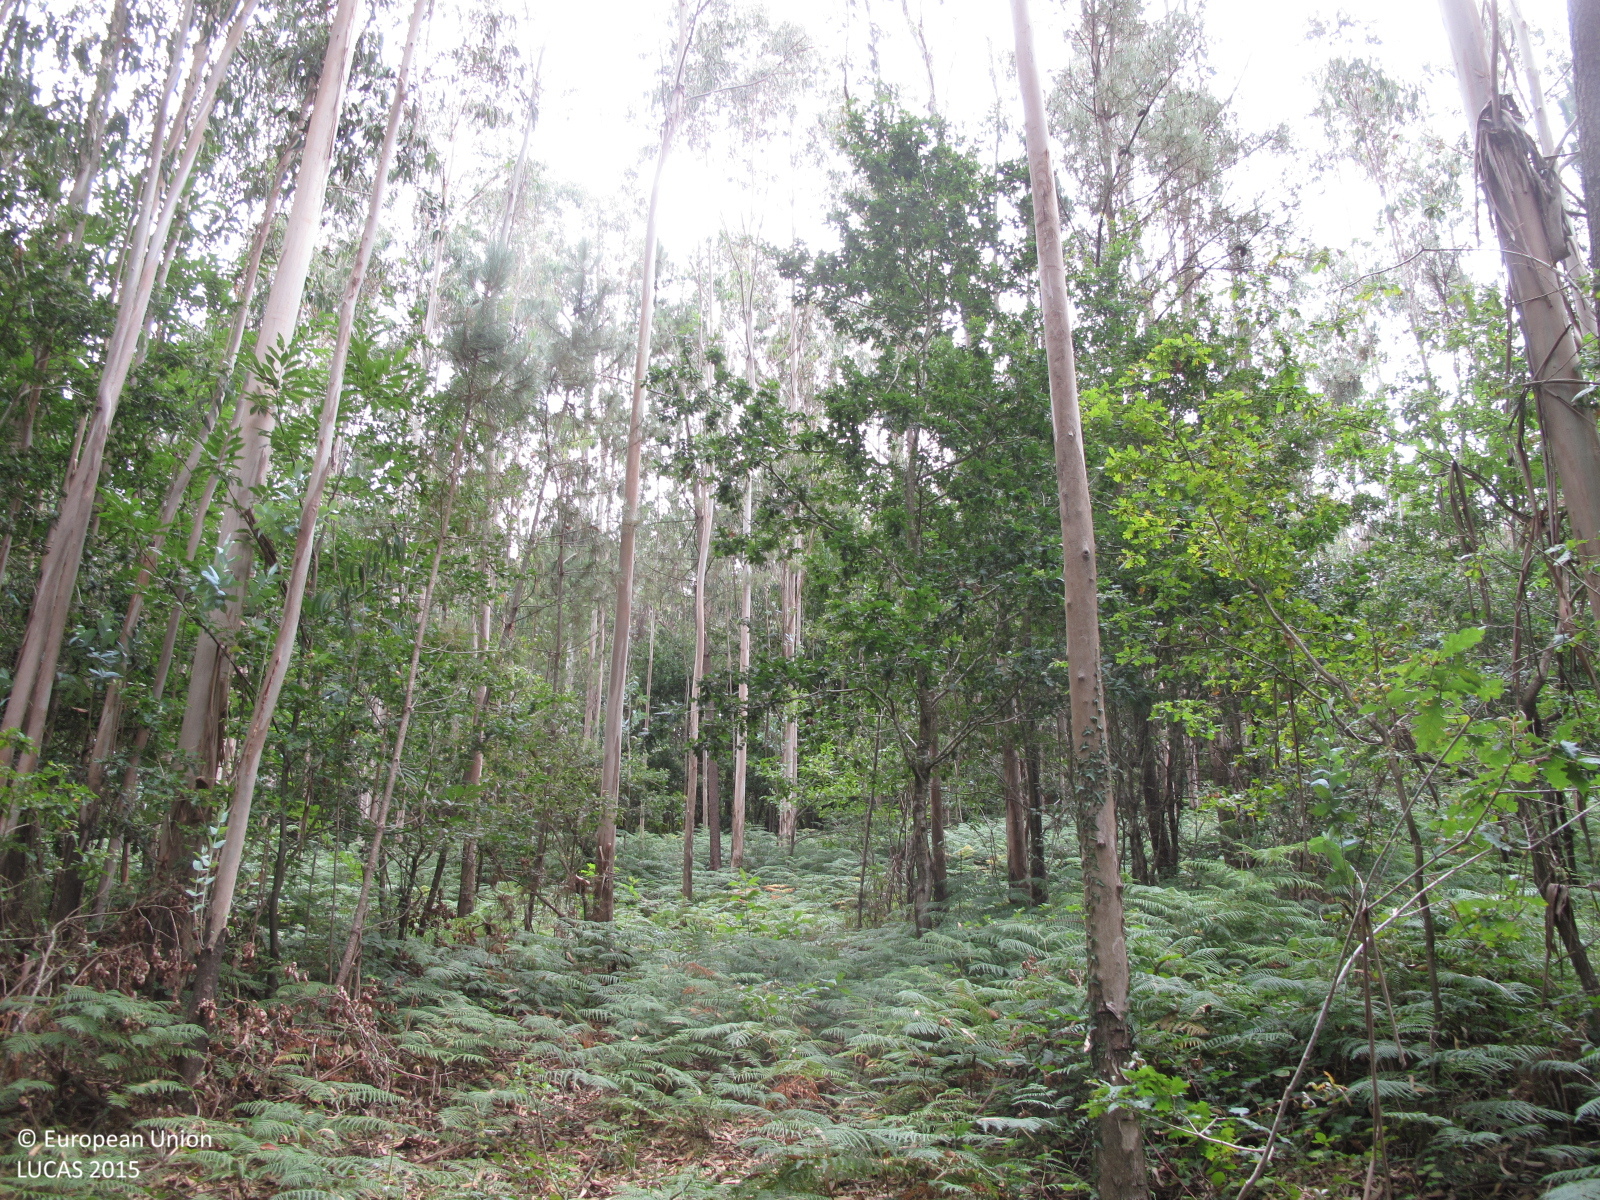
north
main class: Woodland
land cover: Broadleaved woodland
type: exotic forest
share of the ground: 50 - 75 %
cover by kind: broadleaved forest trees 60 %, shrubs 20 %, herbaceous plants 20 %
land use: Forestry
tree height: > 5 m
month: July
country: ES
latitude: 42.8632
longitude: -8.4488
